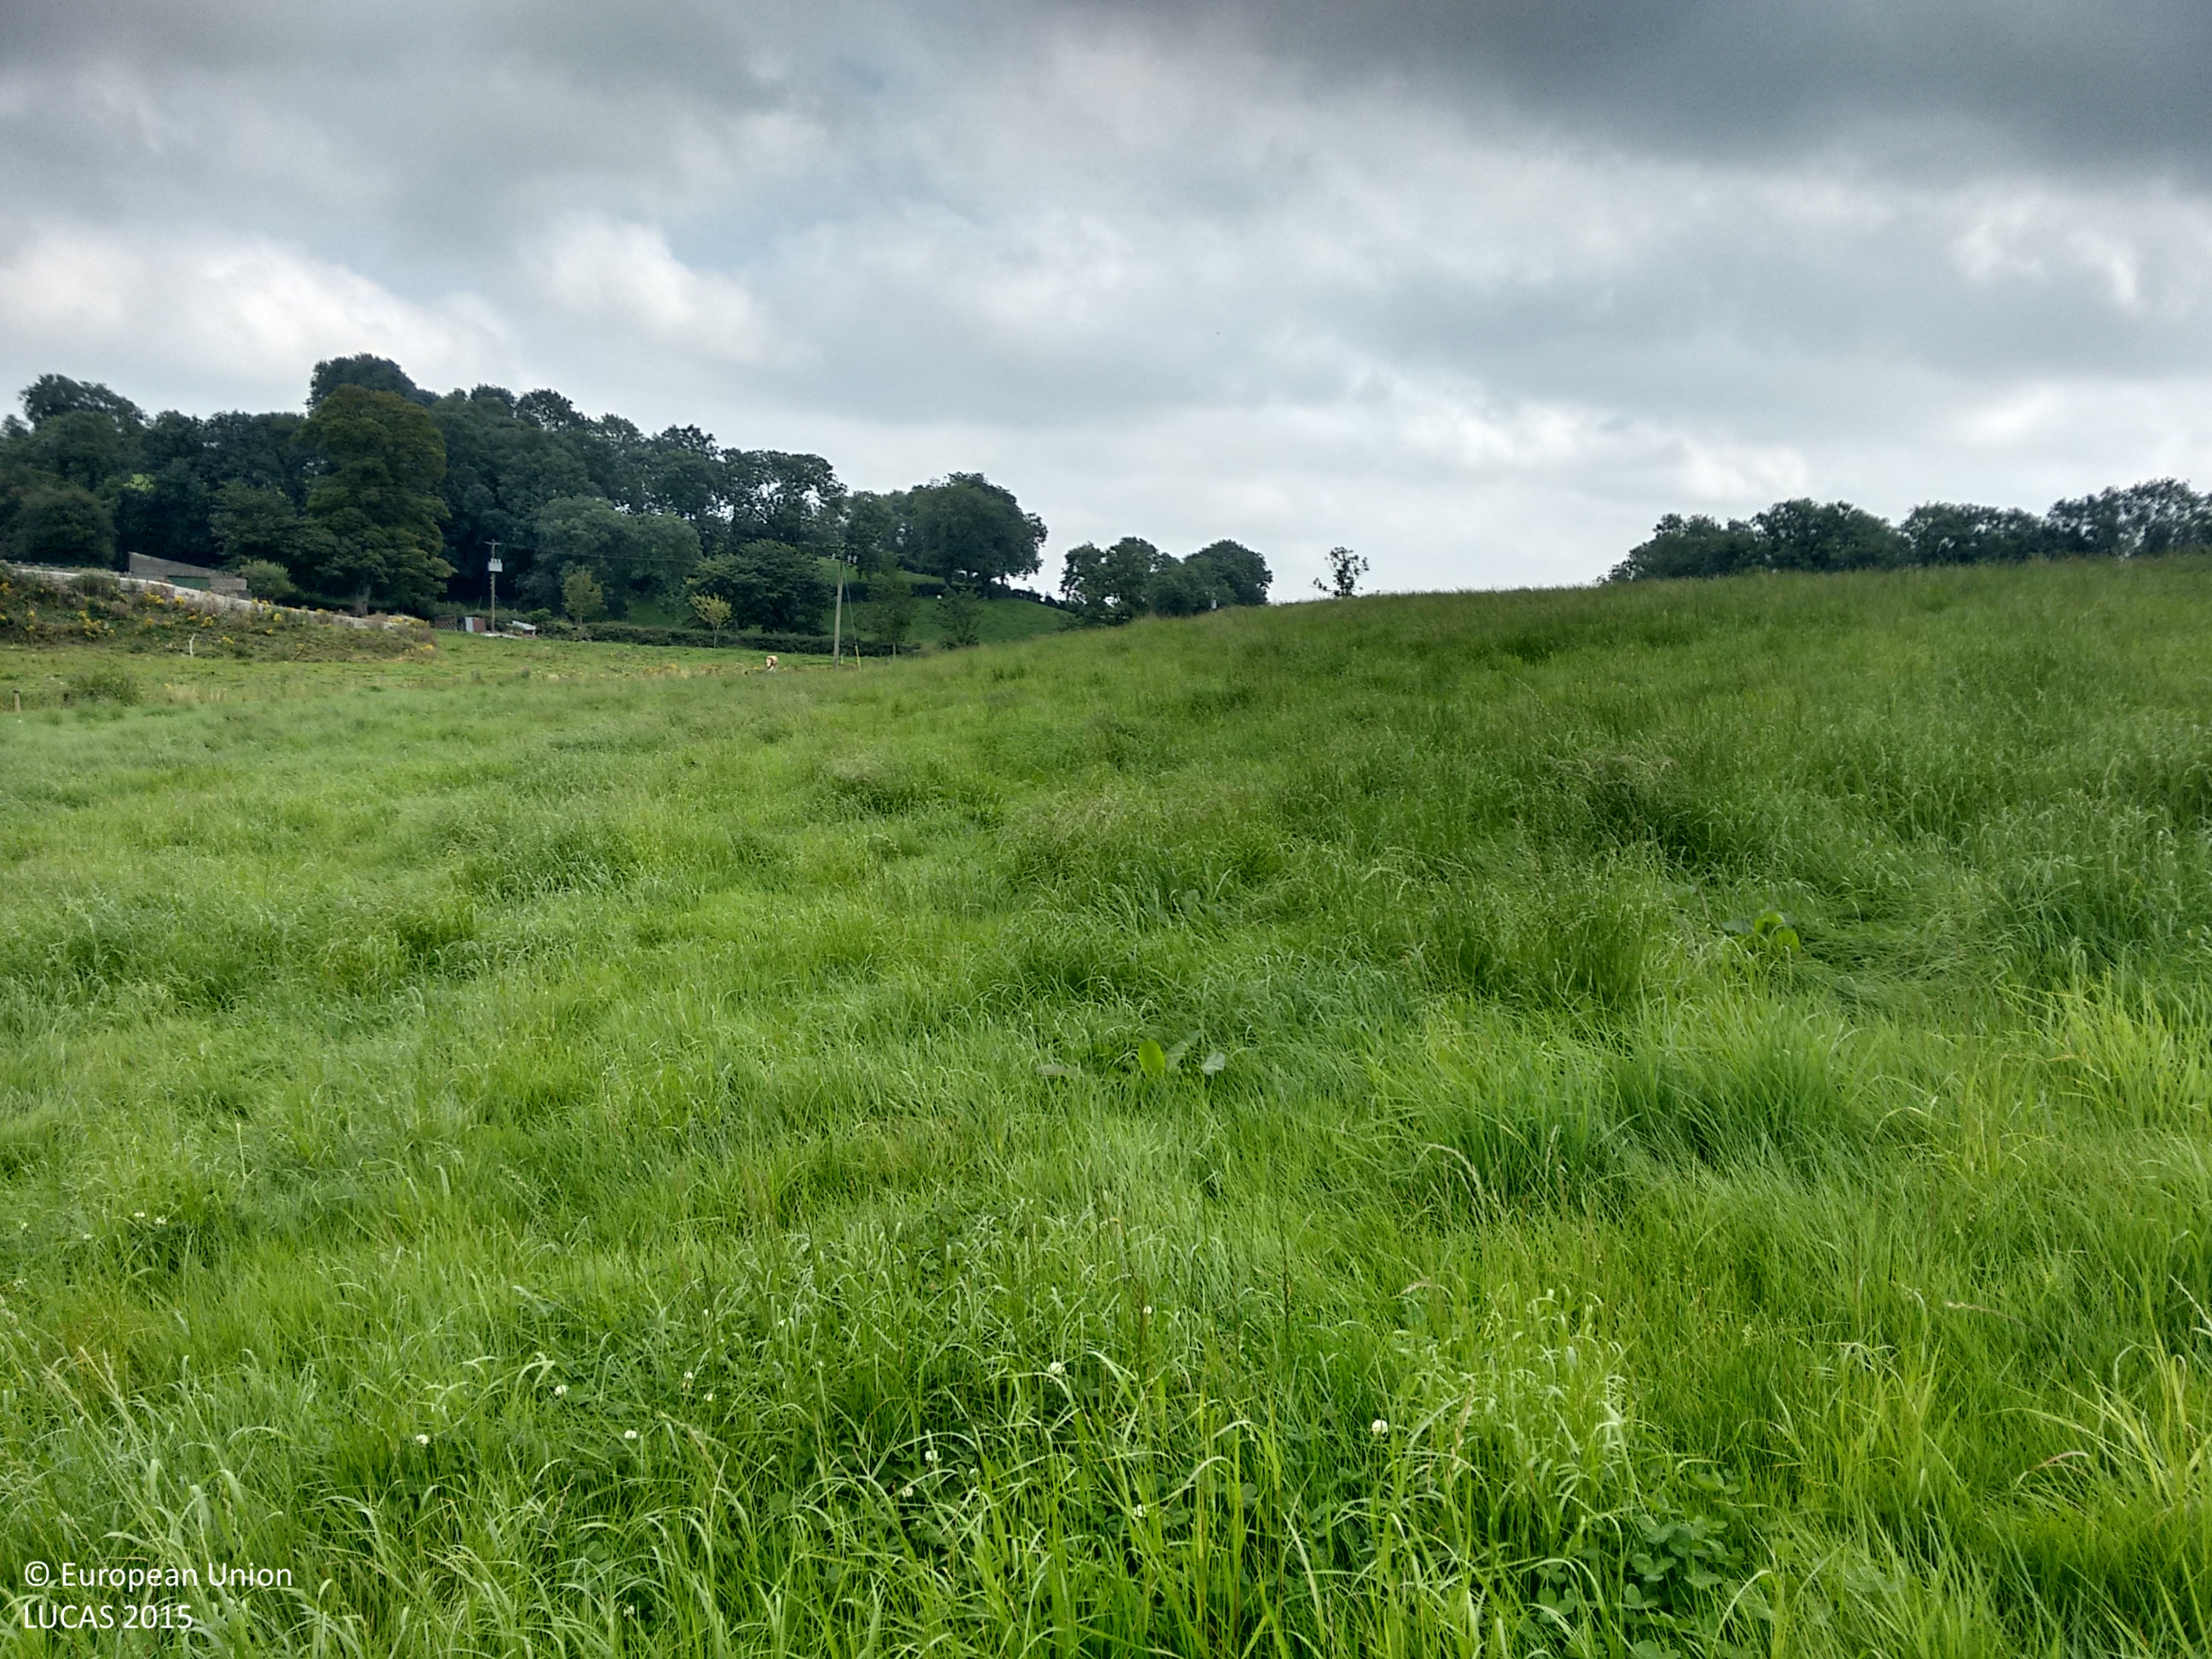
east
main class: Grassland
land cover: Grassland without tree/shrub cover
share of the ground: > 75 %
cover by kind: herbaceous plants 100 %
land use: Agriculture (excluding fallow land and kitchen gardens)
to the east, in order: Grassland without tree/shrub cover; Fences; Grassland without tree/shrub cover; Electric lines; Grassland without tree/shrub cover; Fences; Managed hedges; Grass margins; Tracks; Grass margins; Managed hedges; Fences; Grassland without tree/shrub cover; Electric lines; Grassland without tree/shrub cover; Tracks
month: September
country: IE
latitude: 54.2738
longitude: -7.0811
